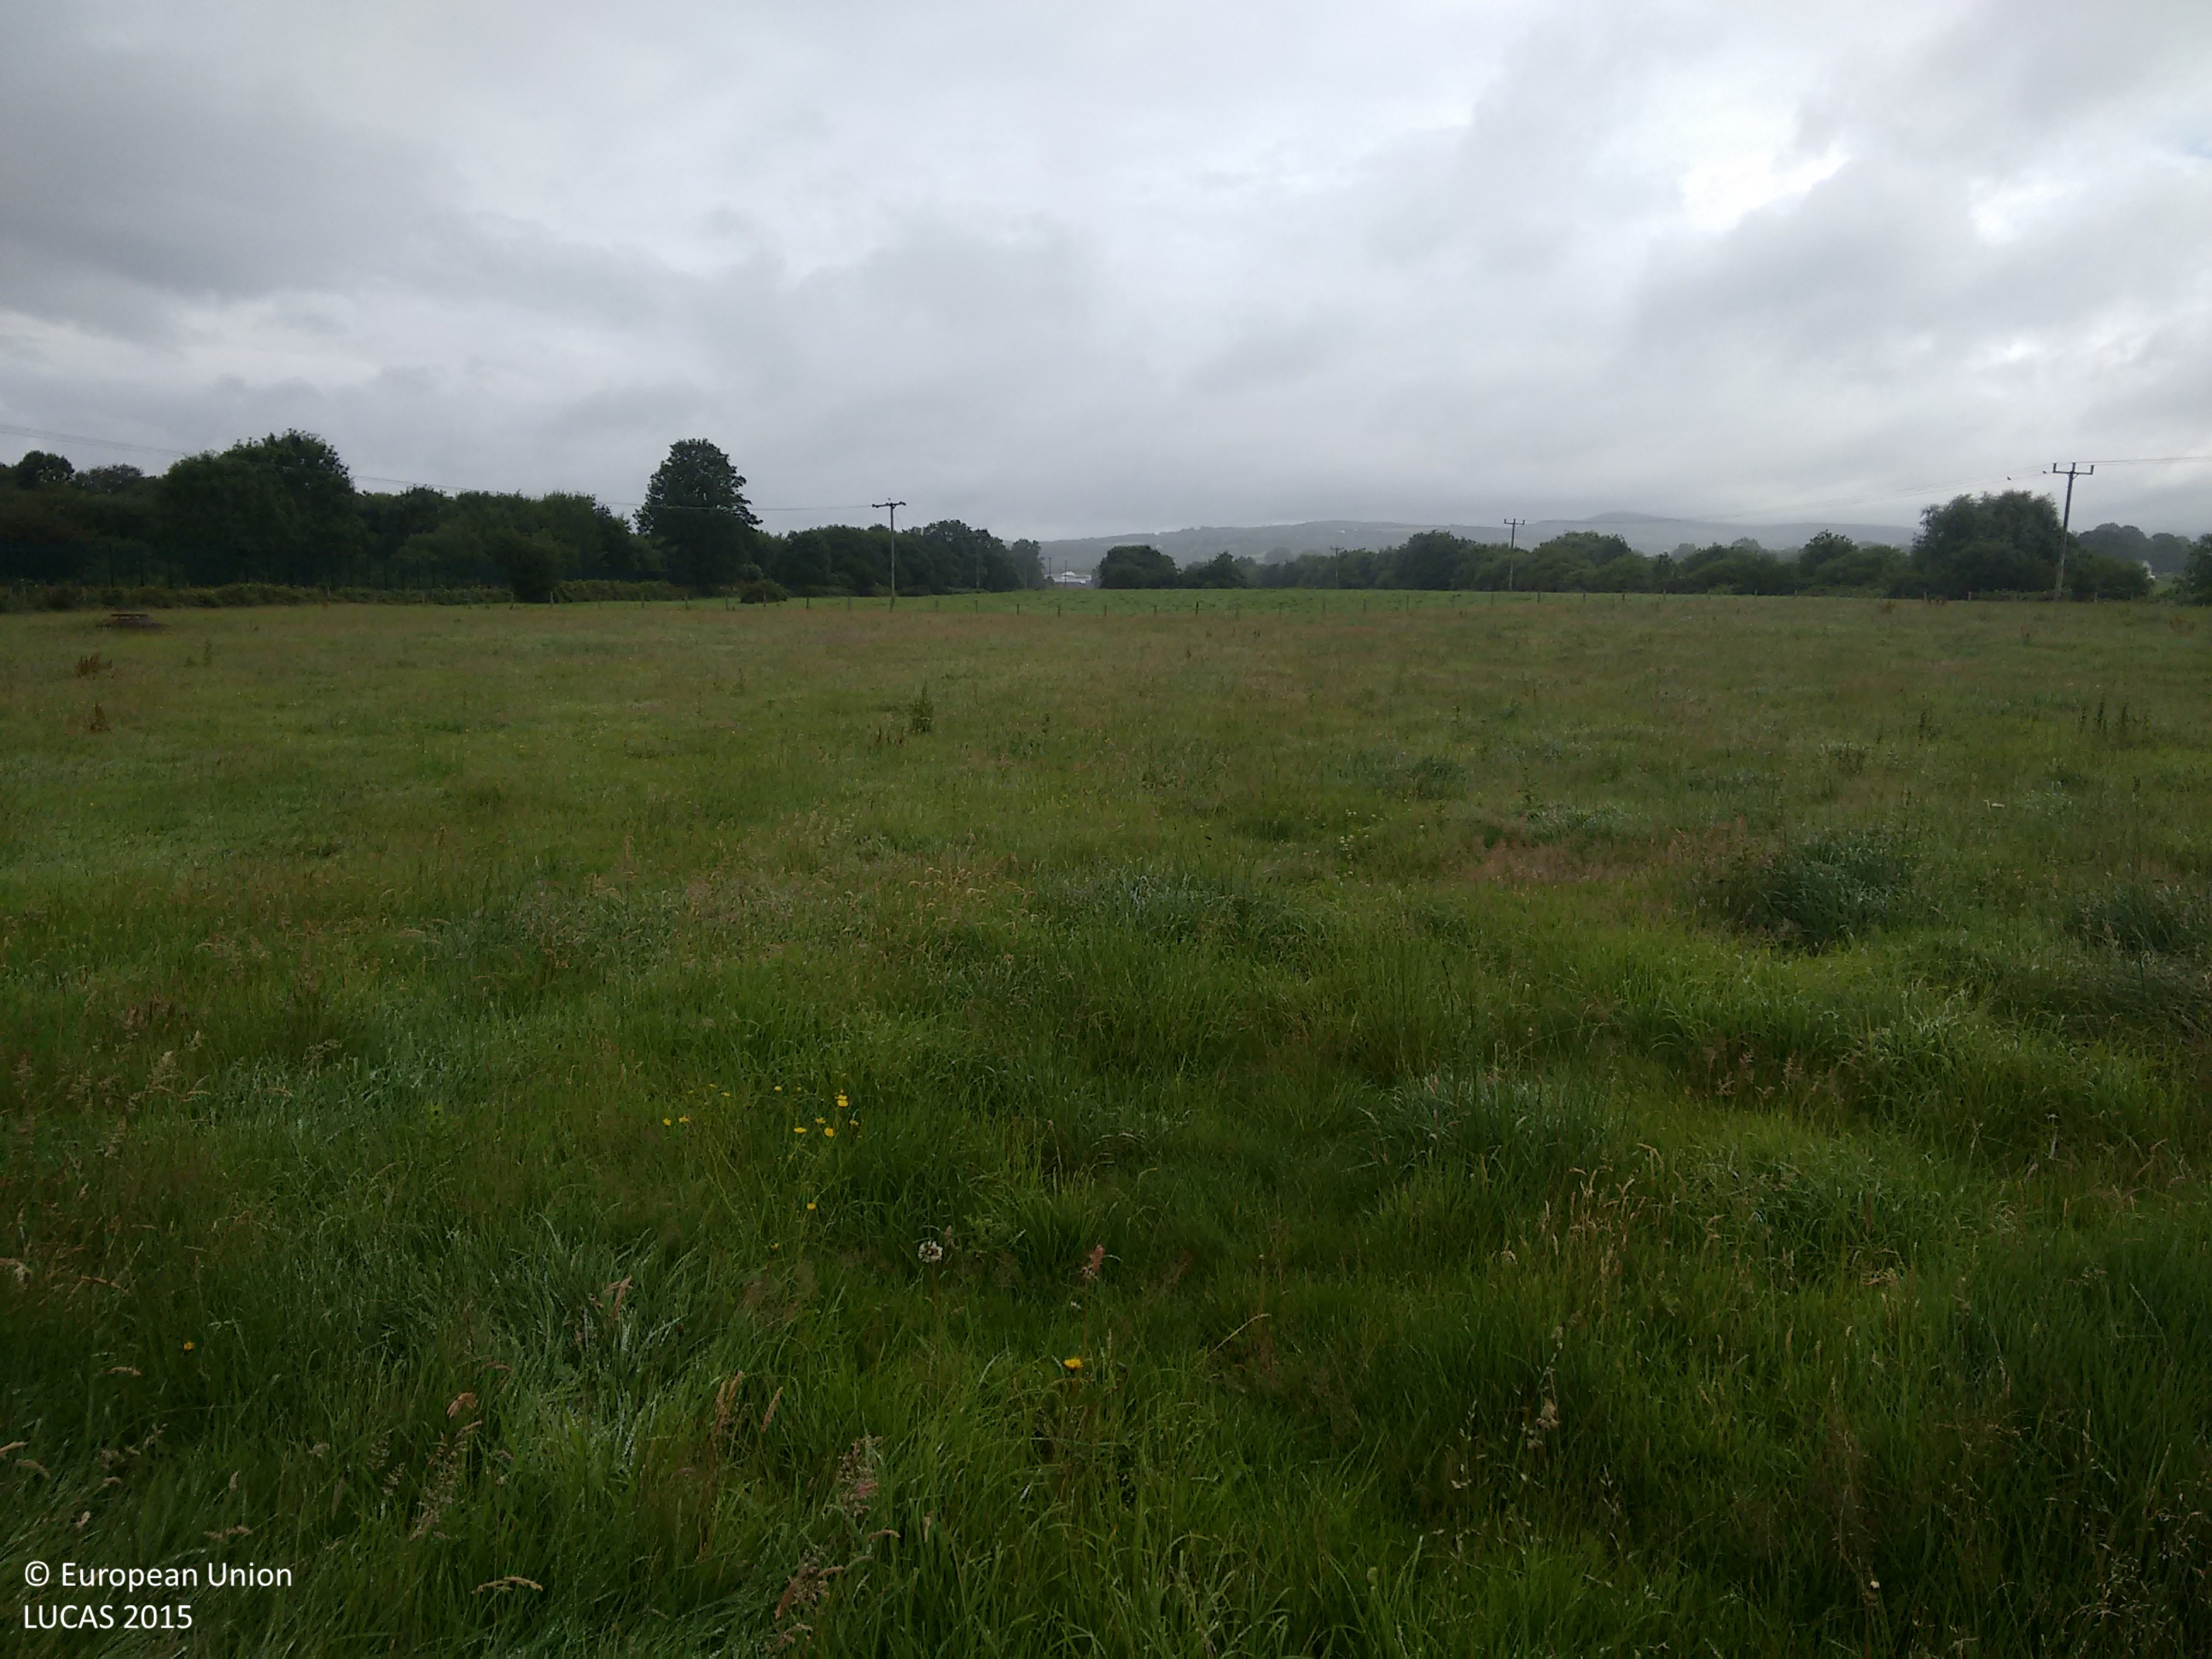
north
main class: Grassland
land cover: Grassland without tree/shrub cover
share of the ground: > 75 %
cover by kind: herbaceous plants 100 %
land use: Agriculture (excluding fallow land and kitchen gardens)
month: July
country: GB
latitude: 51.7803
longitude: -3.9950
